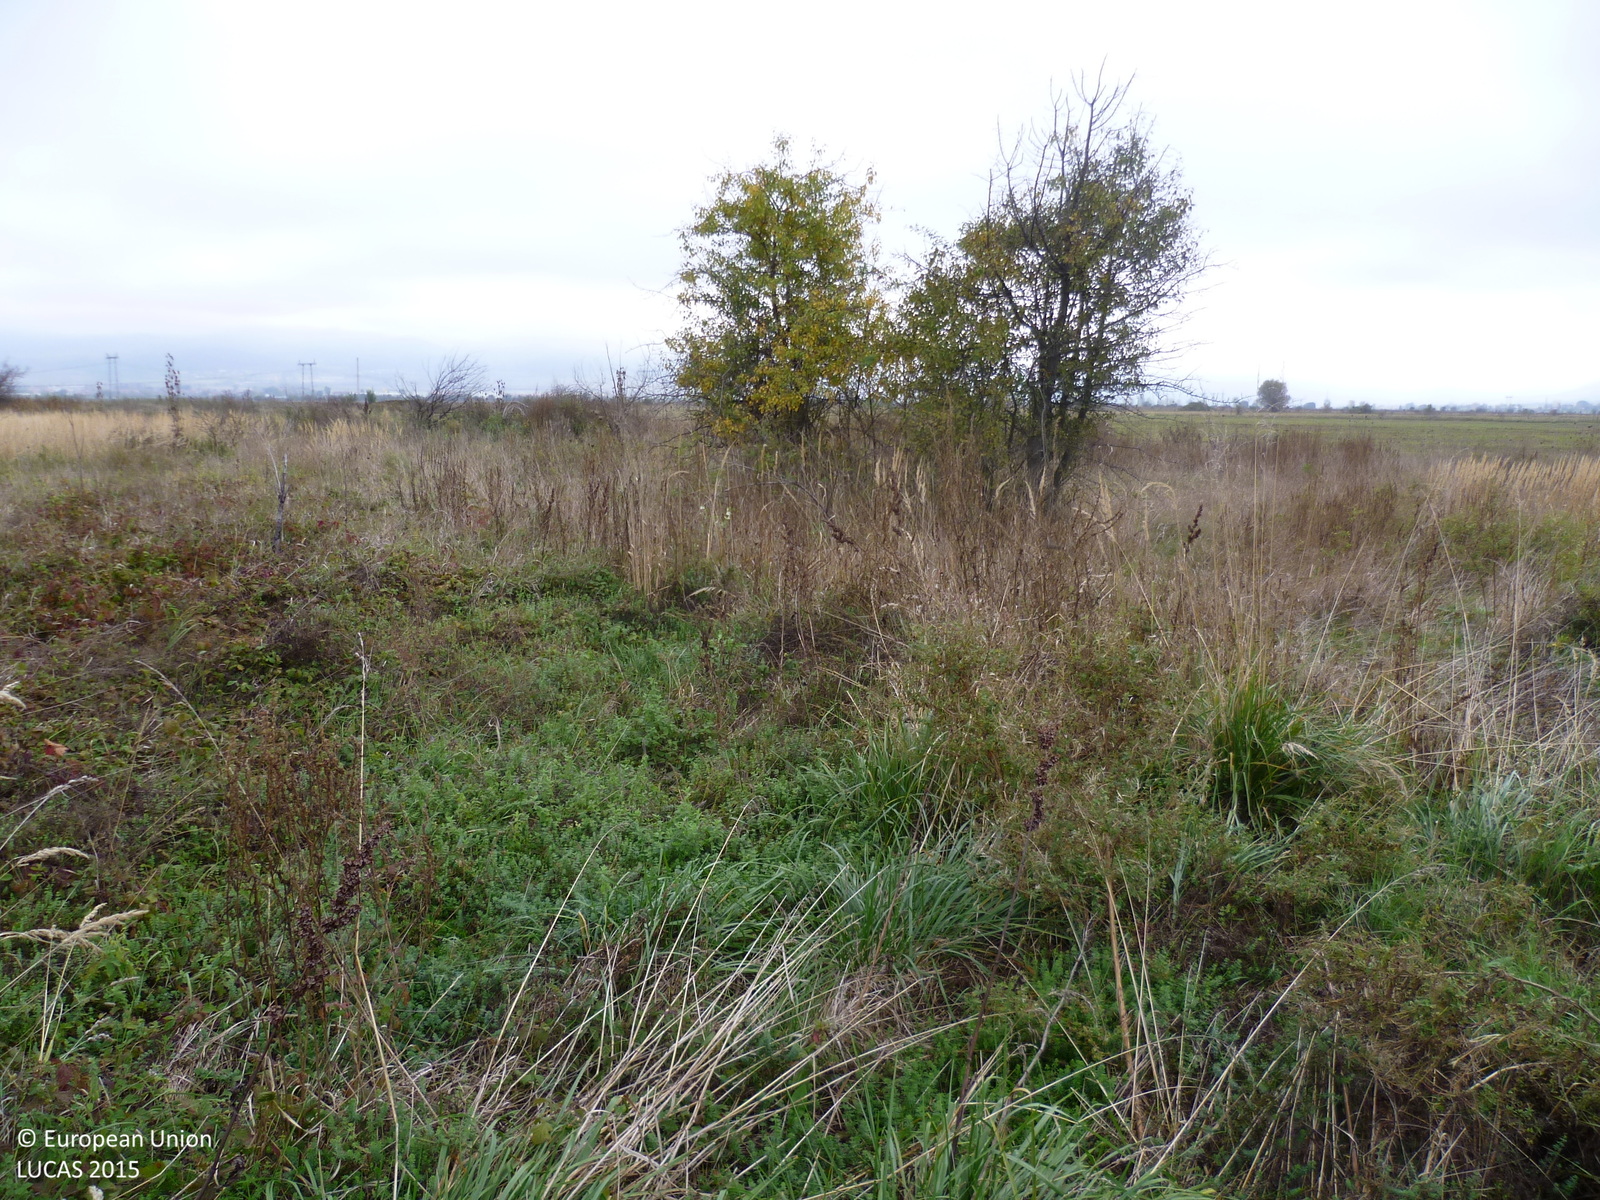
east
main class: Grassland
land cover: Grassland with sparse tree/shrub cover
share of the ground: > 75 %
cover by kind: herbaceous plants 90 %, broadleaved forest trees 5 %, shrubs 5 %
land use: Semi-natural and natural areas not in use
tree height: > 5 m
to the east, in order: Grassland with sparse tree/shrub cover; Grassland without tree/shrub cover; Tracks; Common wheat; Grass margins; Common wheat
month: October
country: BG
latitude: 42.4200
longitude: 23.7834
